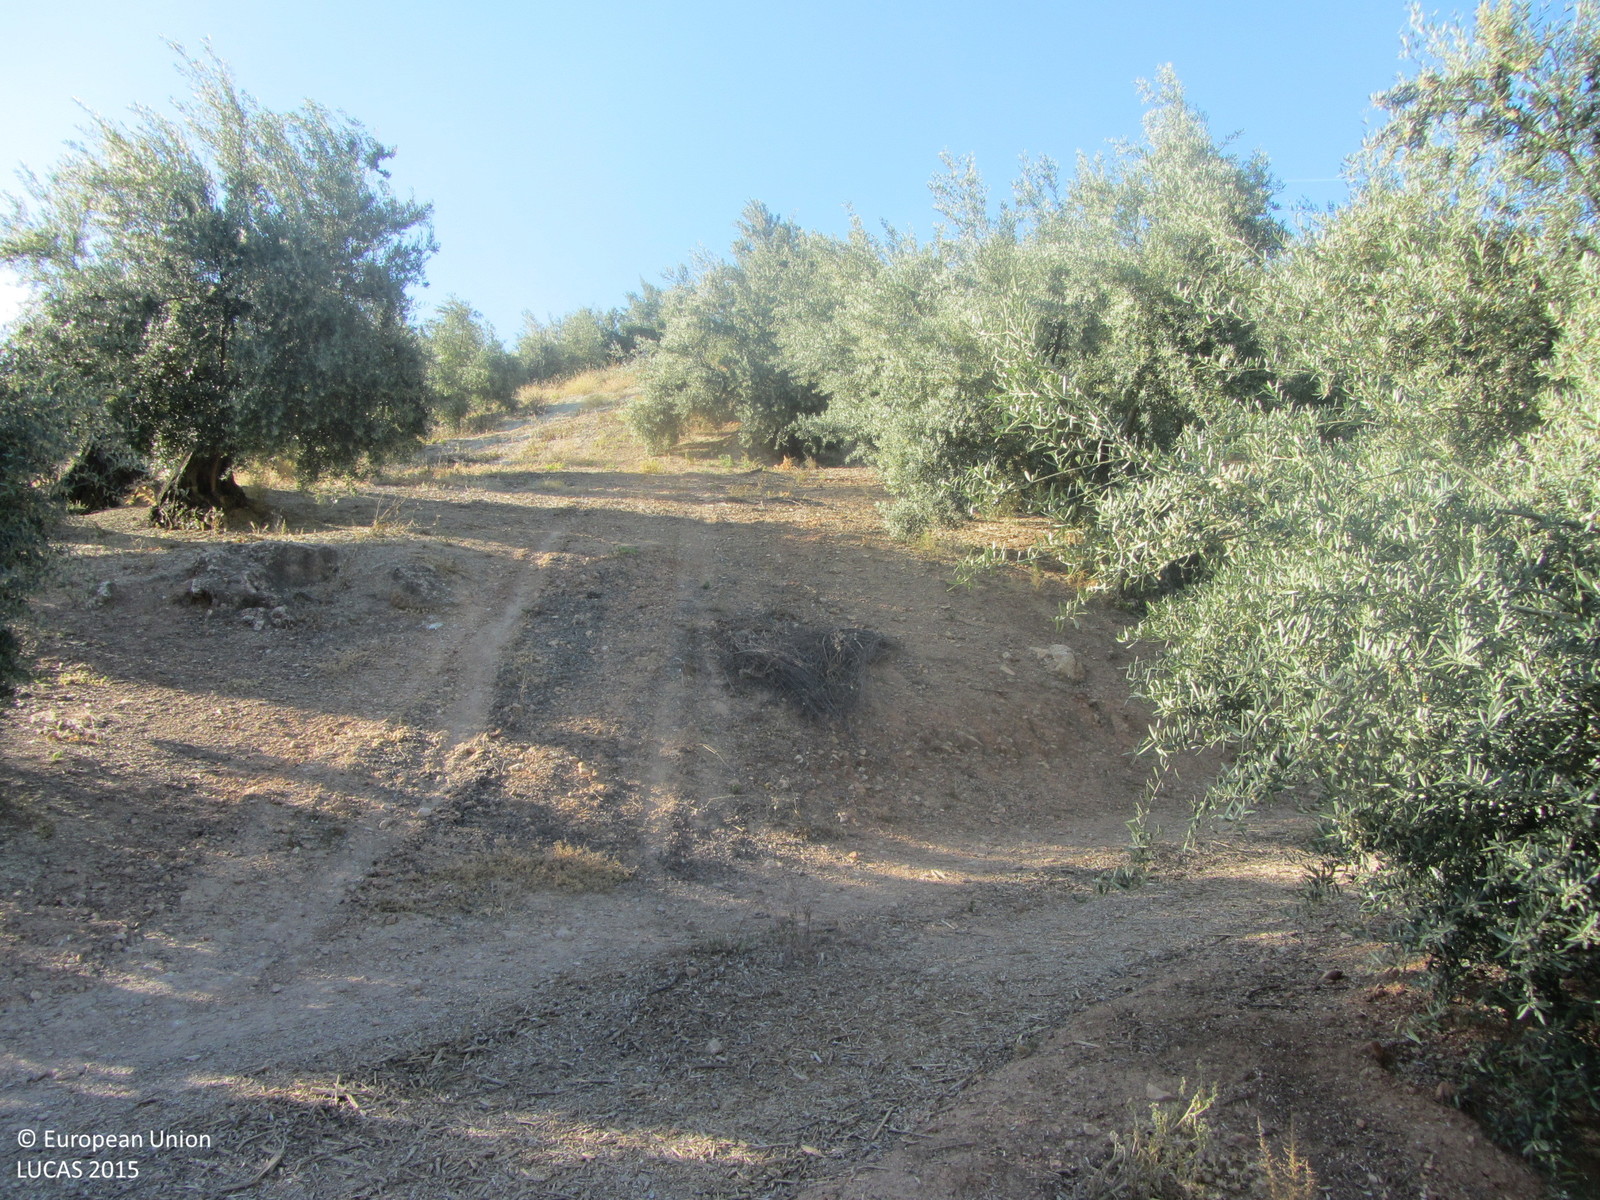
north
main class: Cropland
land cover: Olive groves
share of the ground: 25 - 50 %
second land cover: Other bare soil
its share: > 75 %
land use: Agriculture (excluding fallow land and kitchen gardens)
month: May
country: ES
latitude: 38.1177
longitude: -2.9897
